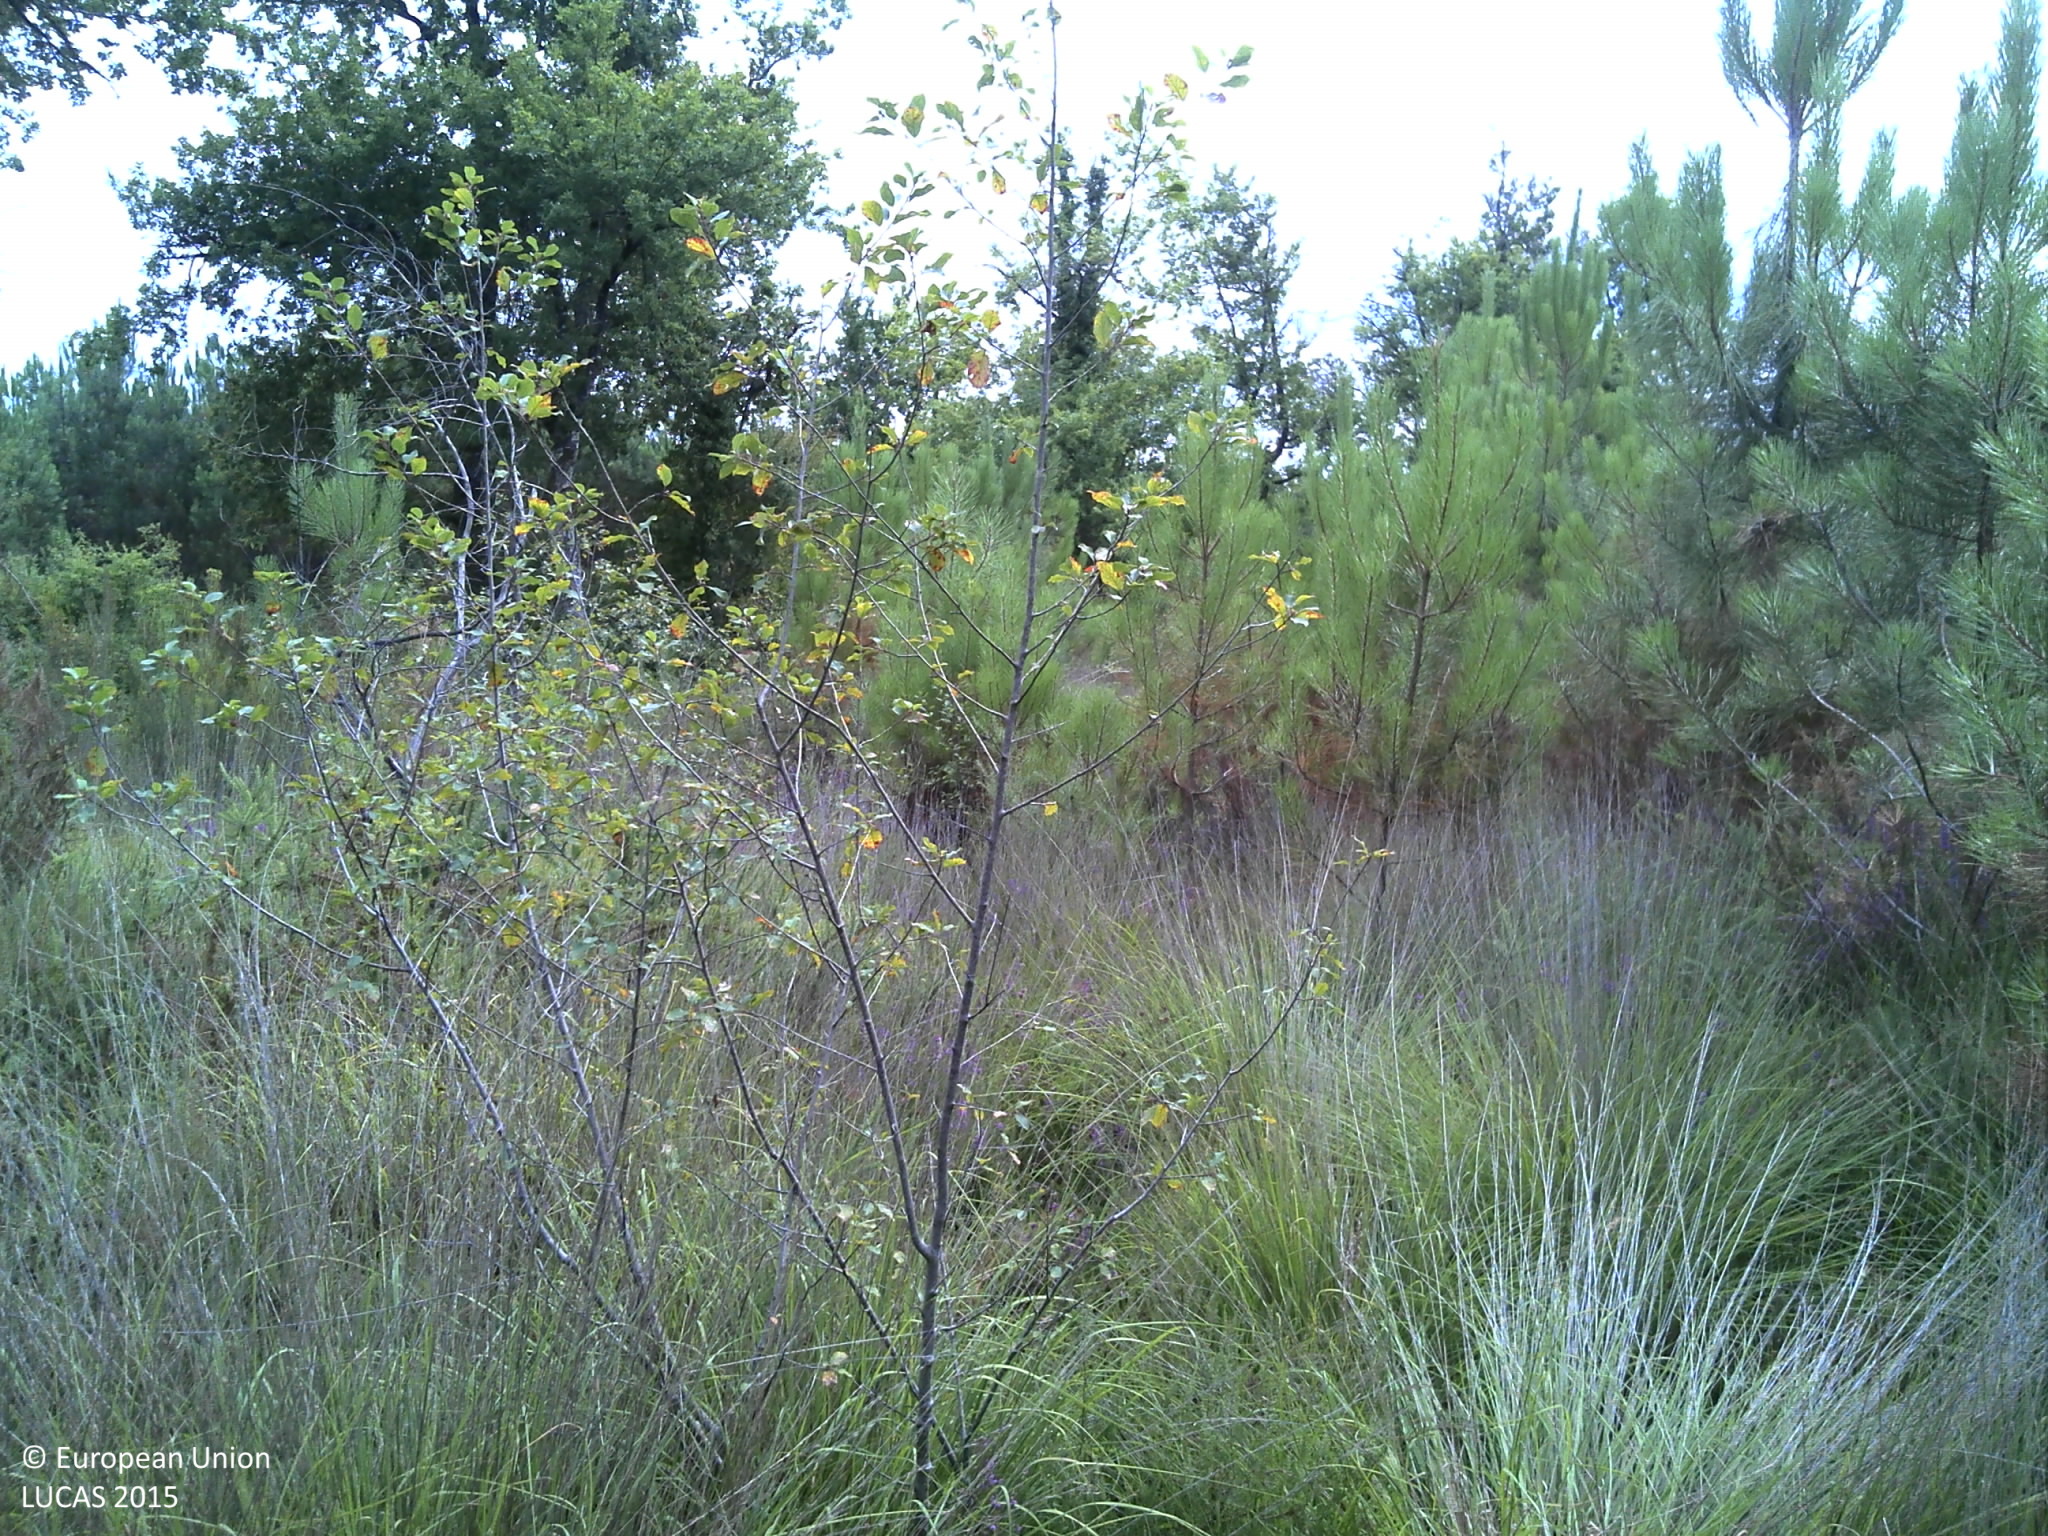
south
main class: Woodland
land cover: Pine dominated coniferous woodland
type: coniferous forest of the mediterranean region
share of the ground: 50 - 75 %
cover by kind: coniferous forest trees 60 %, shrubs 30 %, herbaceous plants 5 %, lichens and mosses 5 %
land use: Forestry
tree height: > 5 m
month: July
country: FR
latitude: 44.4948
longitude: -0.4406
